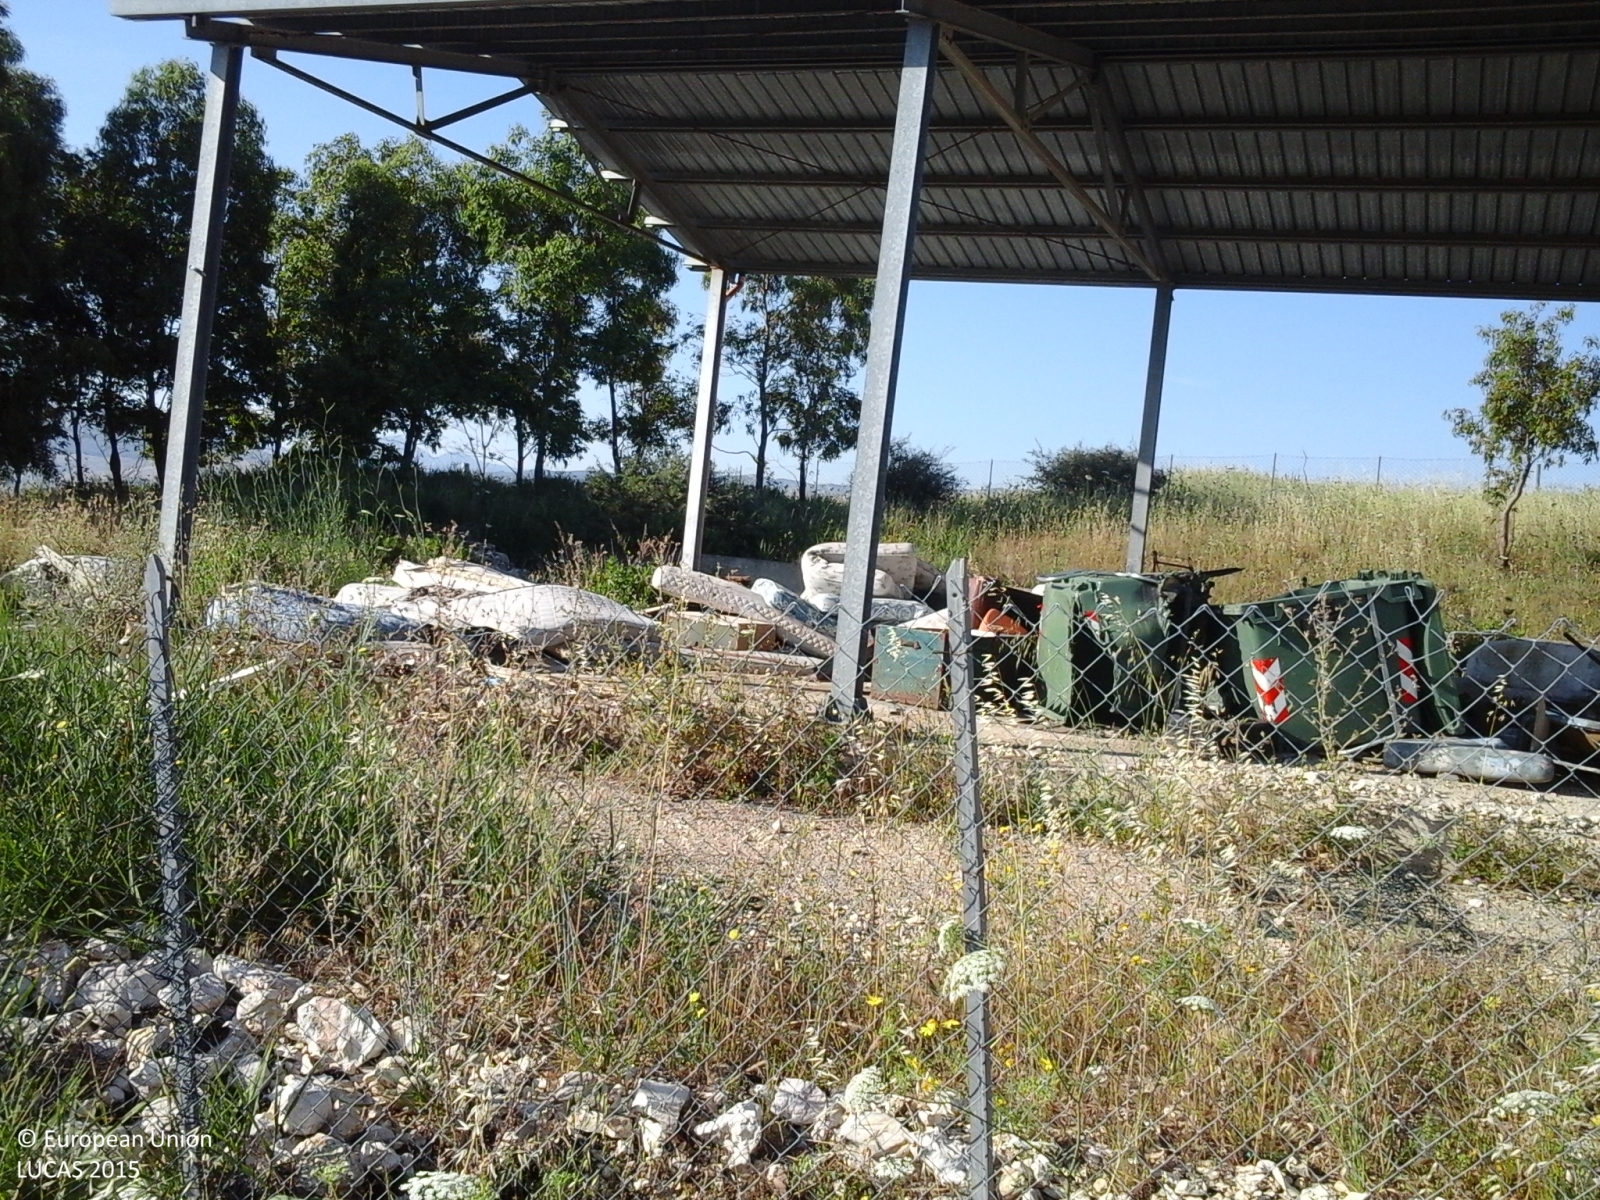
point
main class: Grassland
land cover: Grassland with sparse tree/shrub cover
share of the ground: > 75 %
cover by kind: herbaceous plants 85 %, shrubs 10 %, broadleaved forest trees 5 %
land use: Agriculture (excluding fallow land and kitchen gardens)
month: June
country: IT
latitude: 37.8282
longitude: 13.5080
